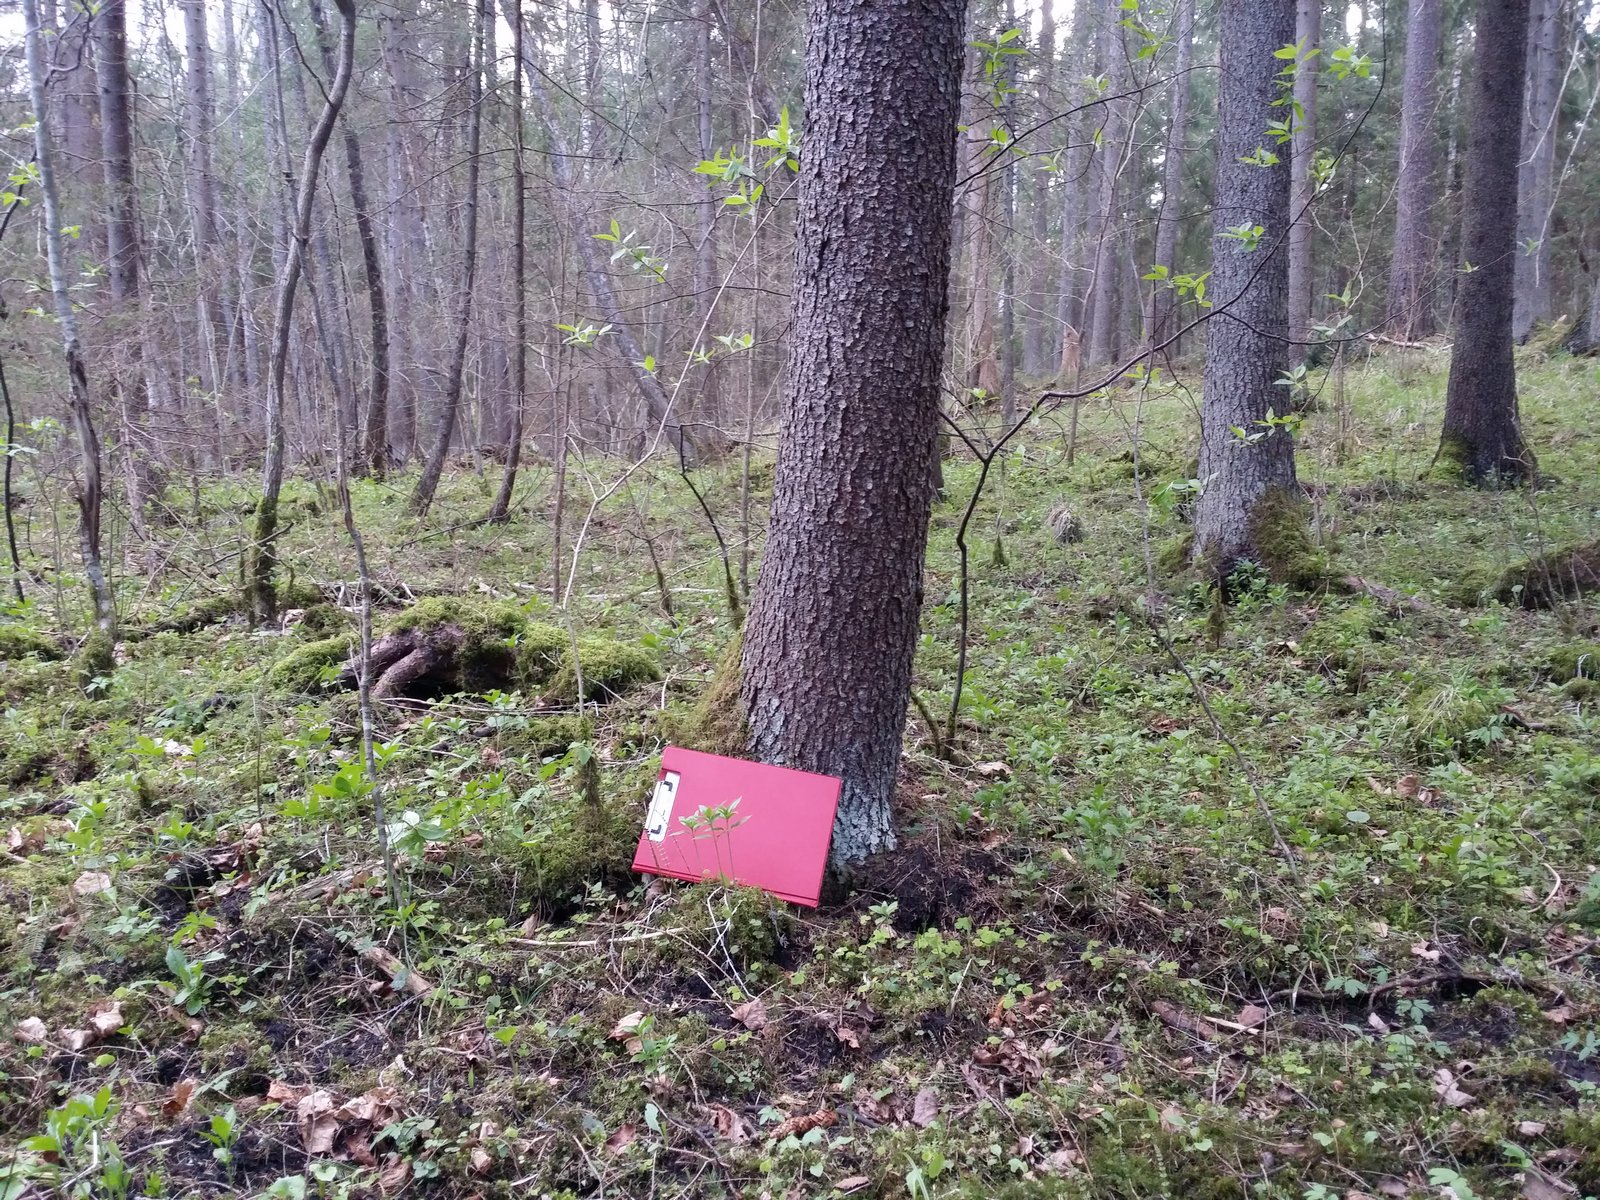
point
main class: Woodland
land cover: Spruce dominated mixed woodland
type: hemiboreal forest and nemoral coniferous forest and mixed broadleaved-coniferous forest
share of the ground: > 75 %
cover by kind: coniferous forest trees 65 %, broadleaved forest trees 25 %, lichens and mosses 10 %
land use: Forestry
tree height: > 5 m
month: May
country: LV
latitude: 57.3785
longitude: 26.0129
